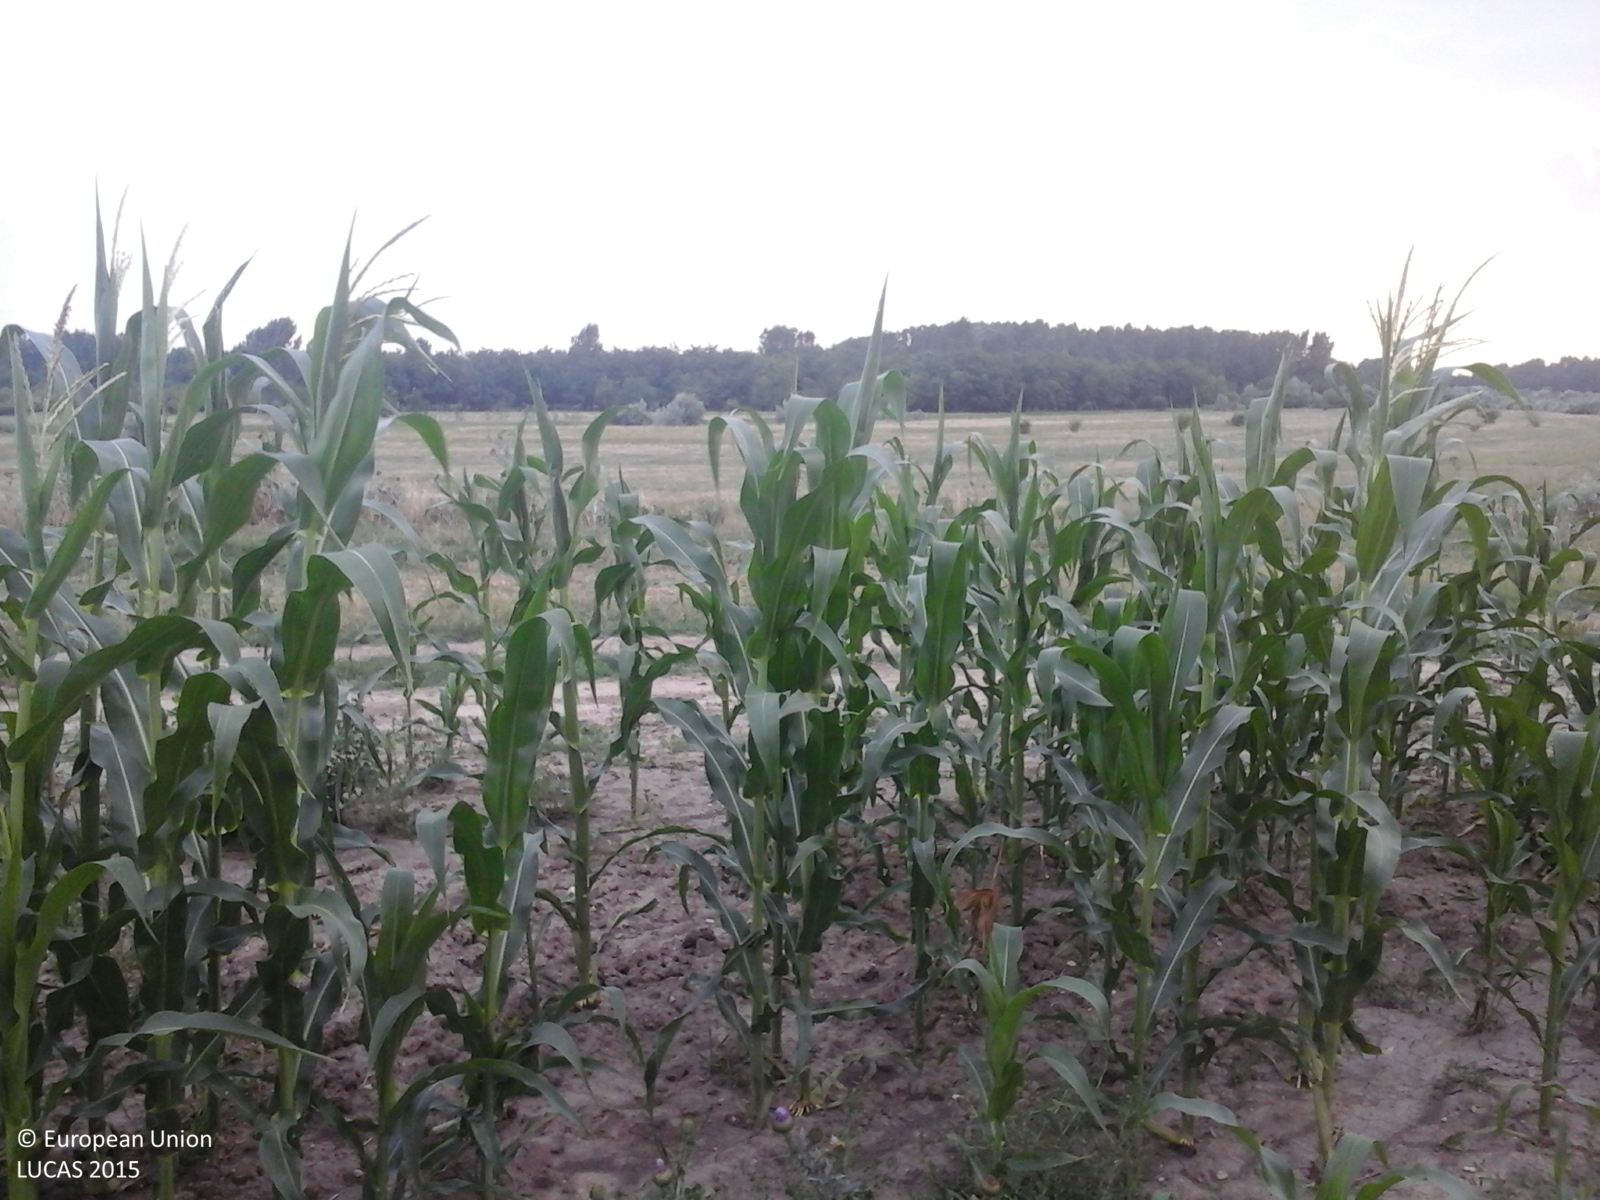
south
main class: Cropland
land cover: Maize
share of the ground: > 75 %
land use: Agriculture (excluding fallow land and kitchen gardens)
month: July
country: RO
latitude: 43.8696
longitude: 24.6648
